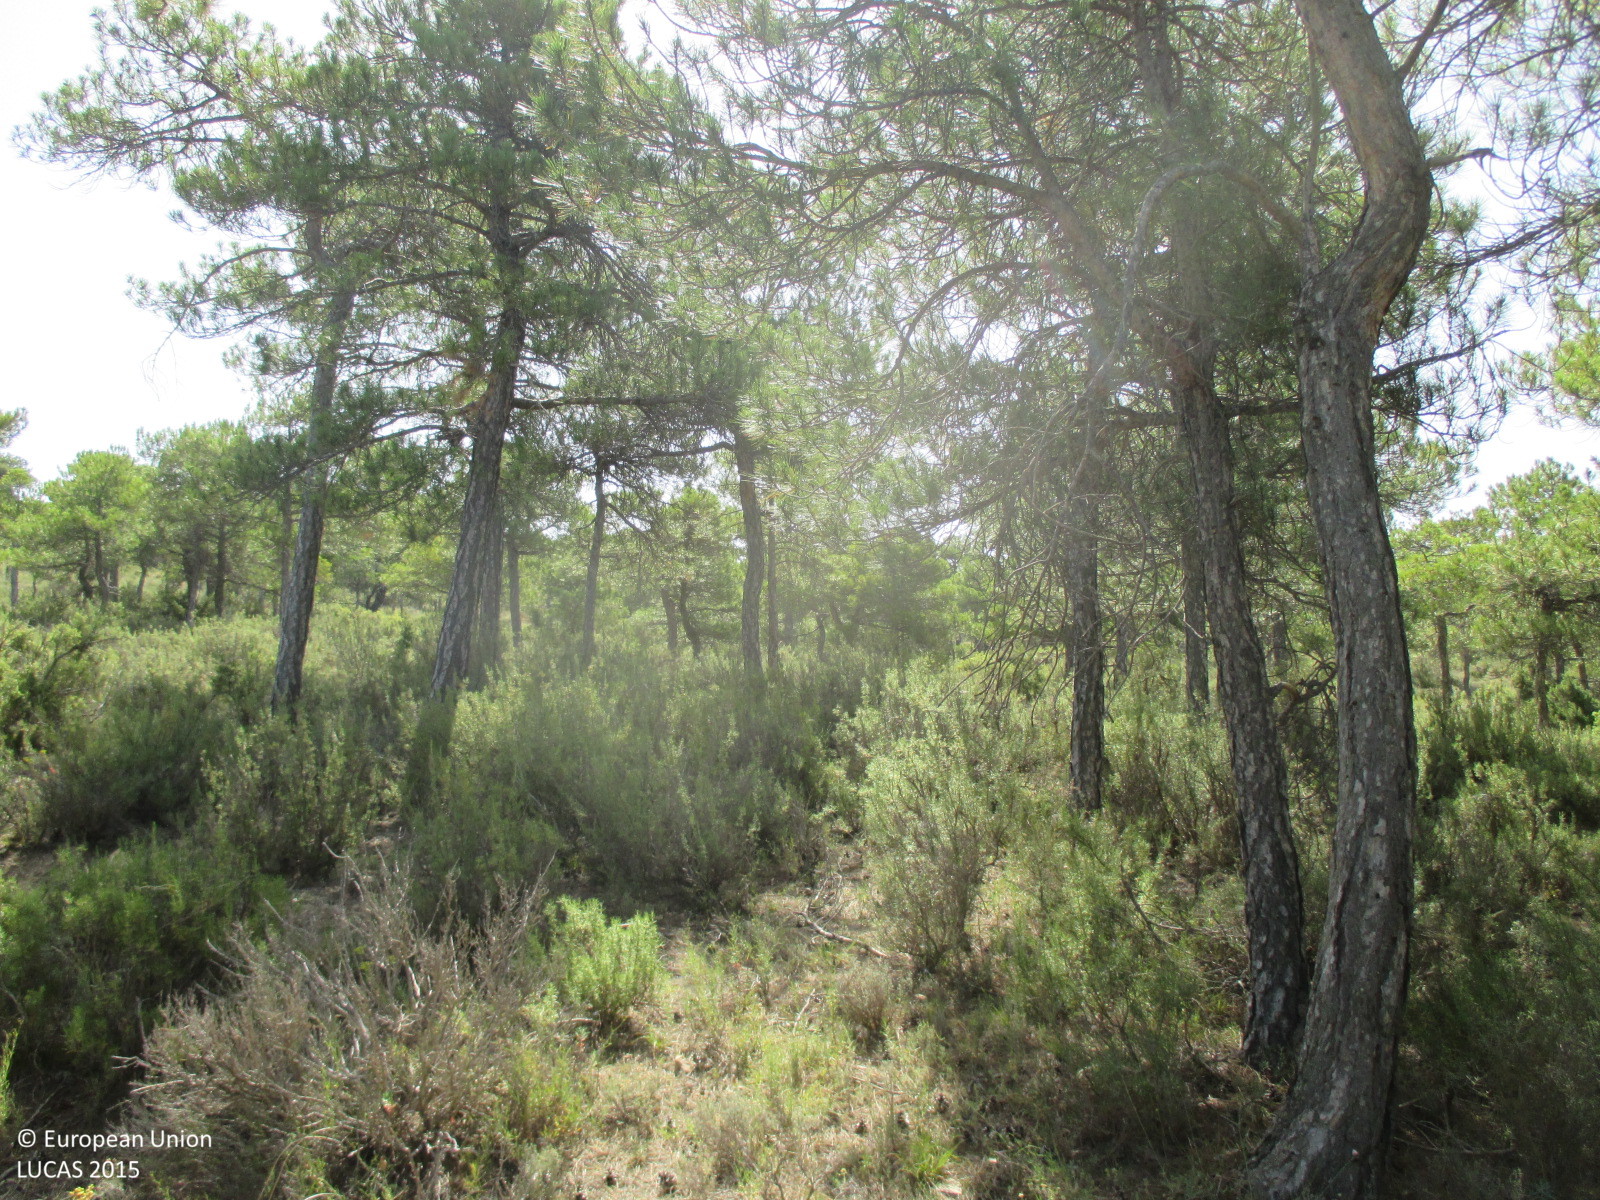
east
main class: Woodland
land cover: Pine dominated coniferous woodland
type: coniferous forest of the mediterranean region
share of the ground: 50 - 75 %
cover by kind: coniferous forest trees 60 %, shrubs 20 %, herbaceous plants 20 %
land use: Forestry
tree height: > 5 m
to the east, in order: Pine dominated coniferous woodland; Paved roads, cycling and walking lanes; Pine dominated coniferous woodland; Shrubland with sparse tree cover; Rivers and streams; Shrubland with sparse tree cover; Tracks; Shrubland with sparse tree cover
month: July
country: ES
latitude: 37.9874
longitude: -2.4595
